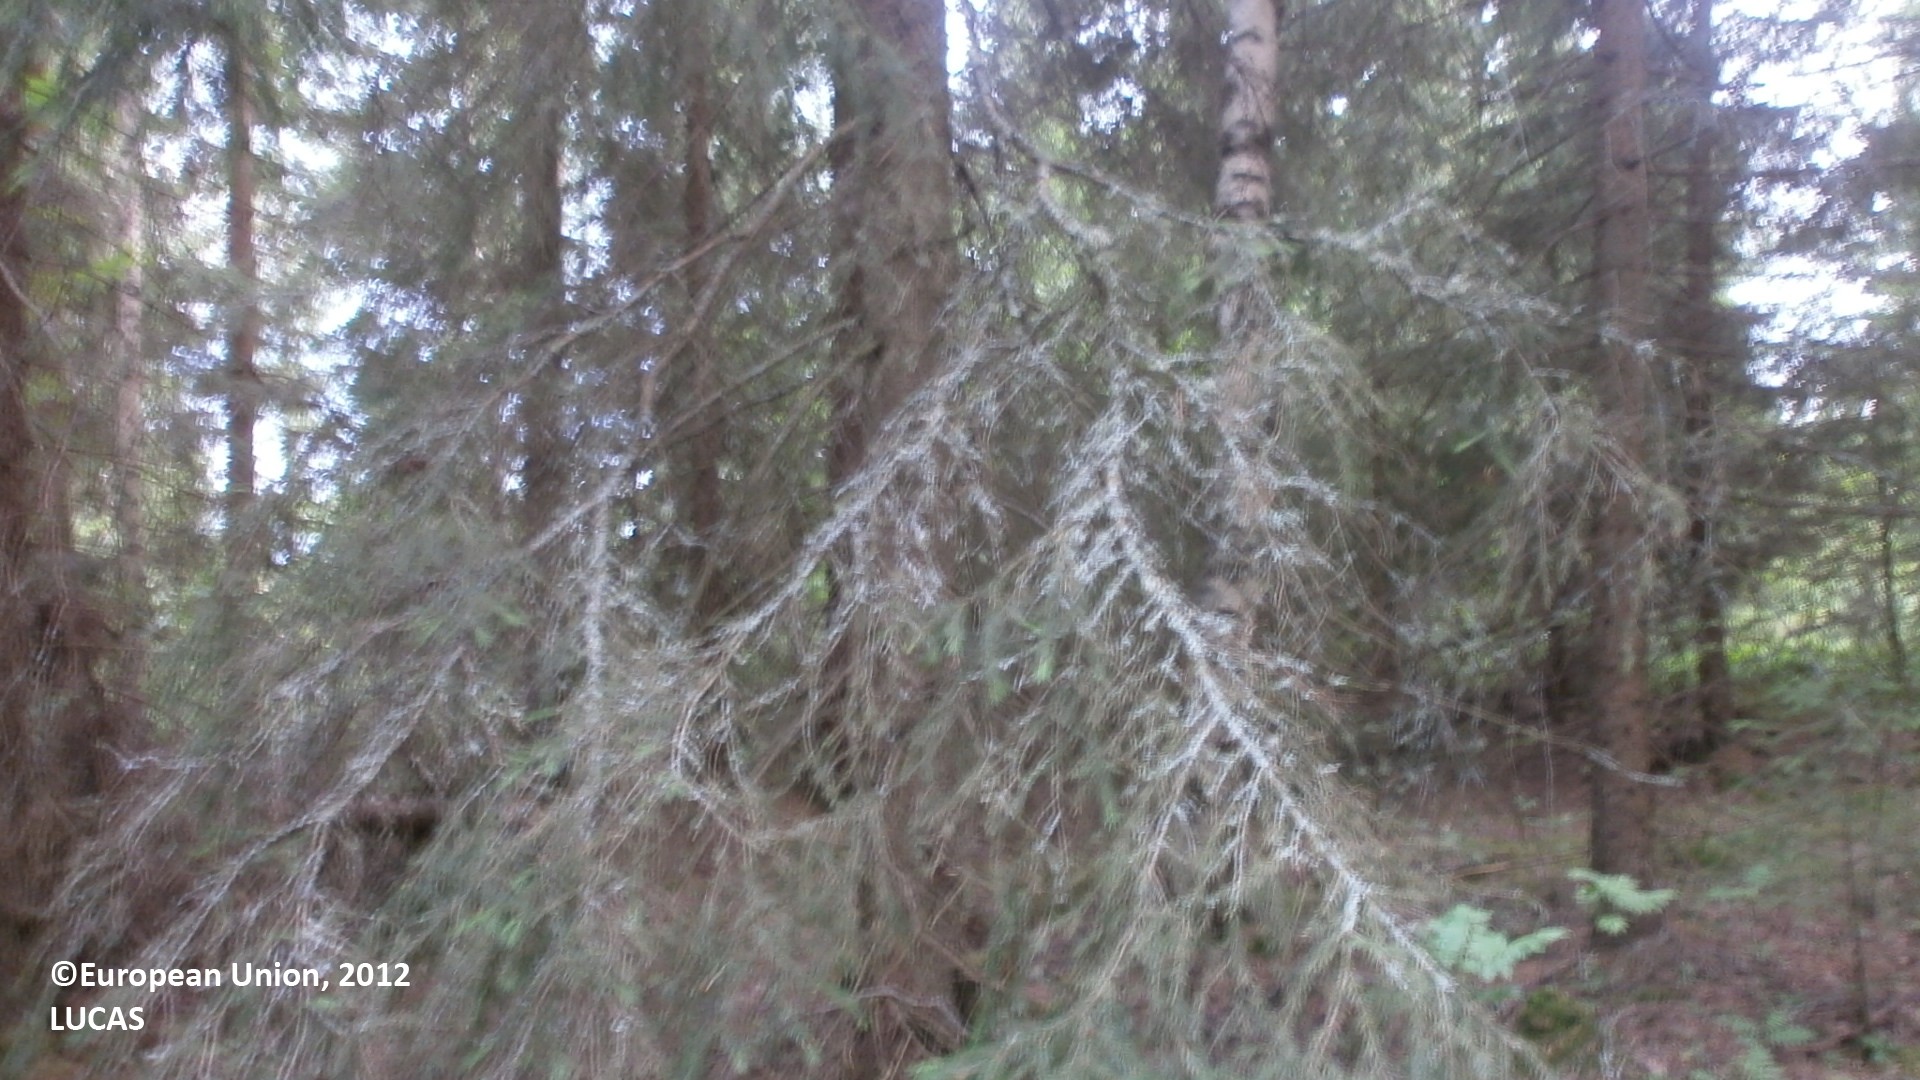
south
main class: Woodland
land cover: Spruce dominated mixed woodland
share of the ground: > 75 %
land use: Forestry
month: July
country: FI
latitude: 64.3046
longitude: 24.4365
